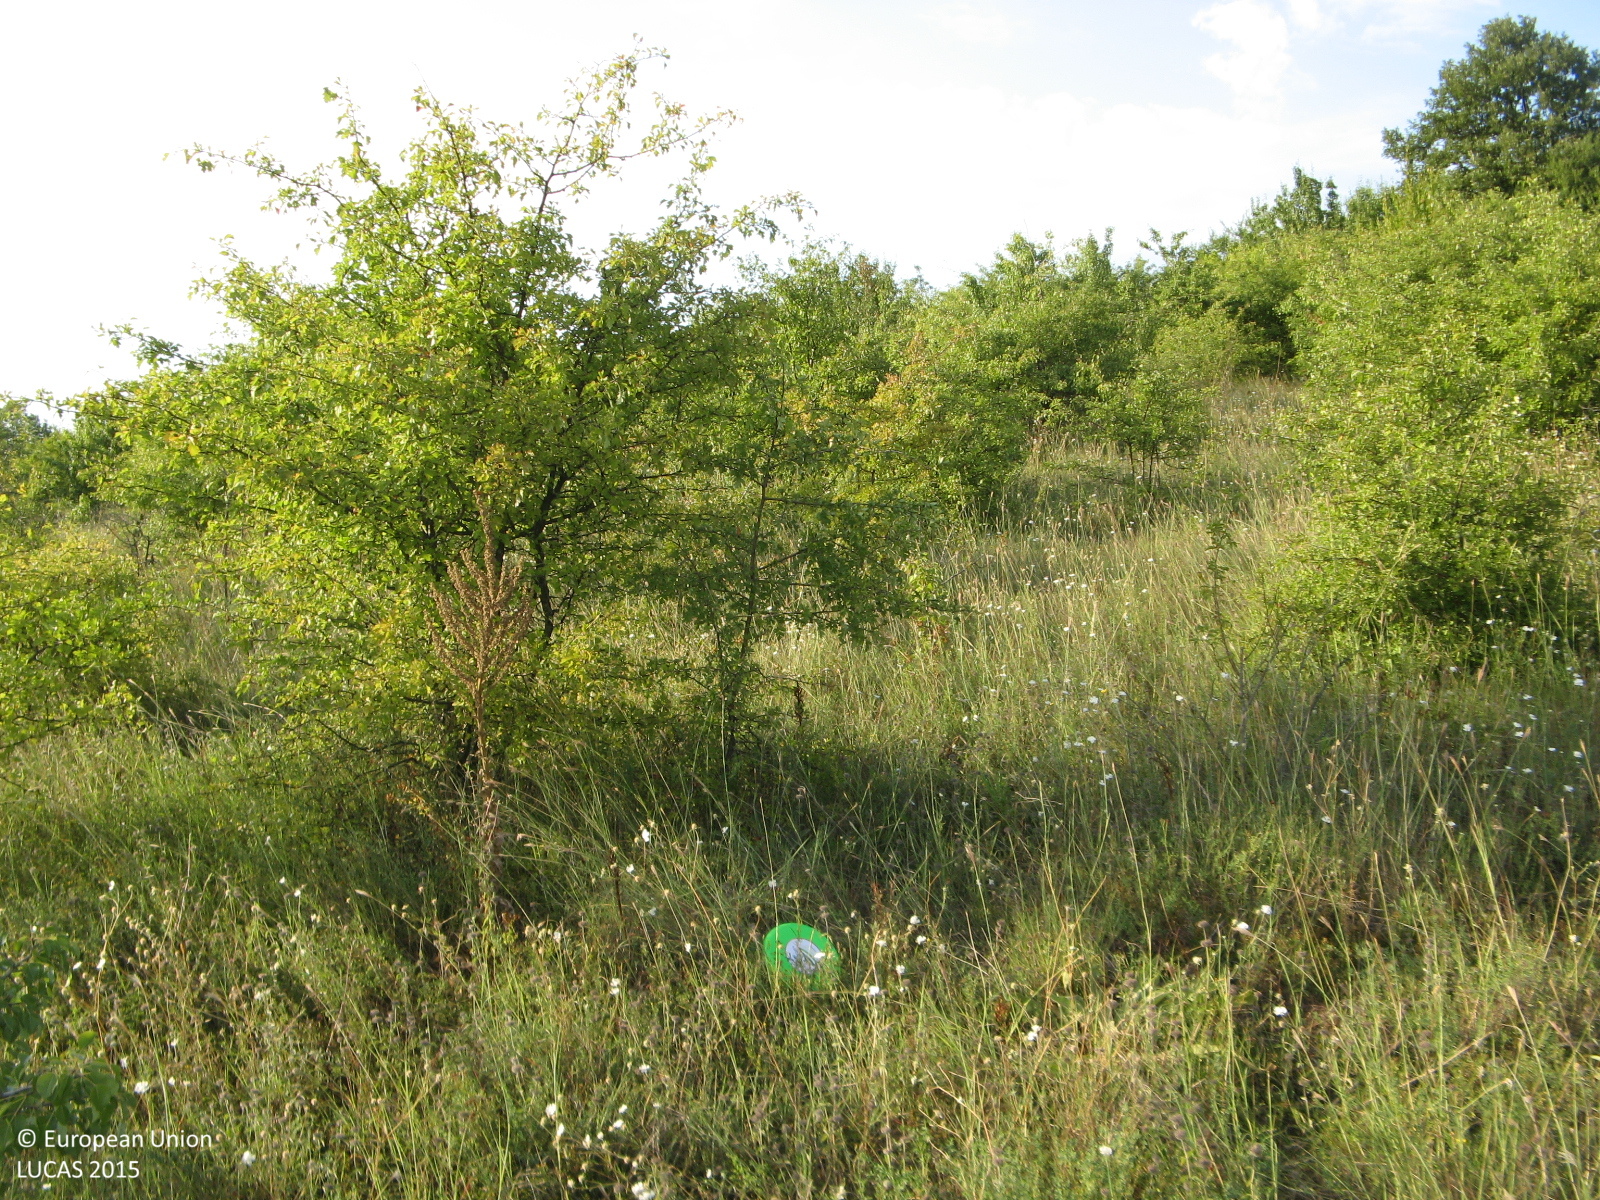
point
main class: Grassland
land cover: Grassland with sparse tree/shrub cover
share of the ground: > 75 %
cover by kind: herbaceous plants 85 %, shrubs 10 %, broadleaved forest trees 5 %
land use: Abandoned areas
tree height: < 5 m
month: August
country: BG
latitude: 43.5321
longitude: 25.8163
